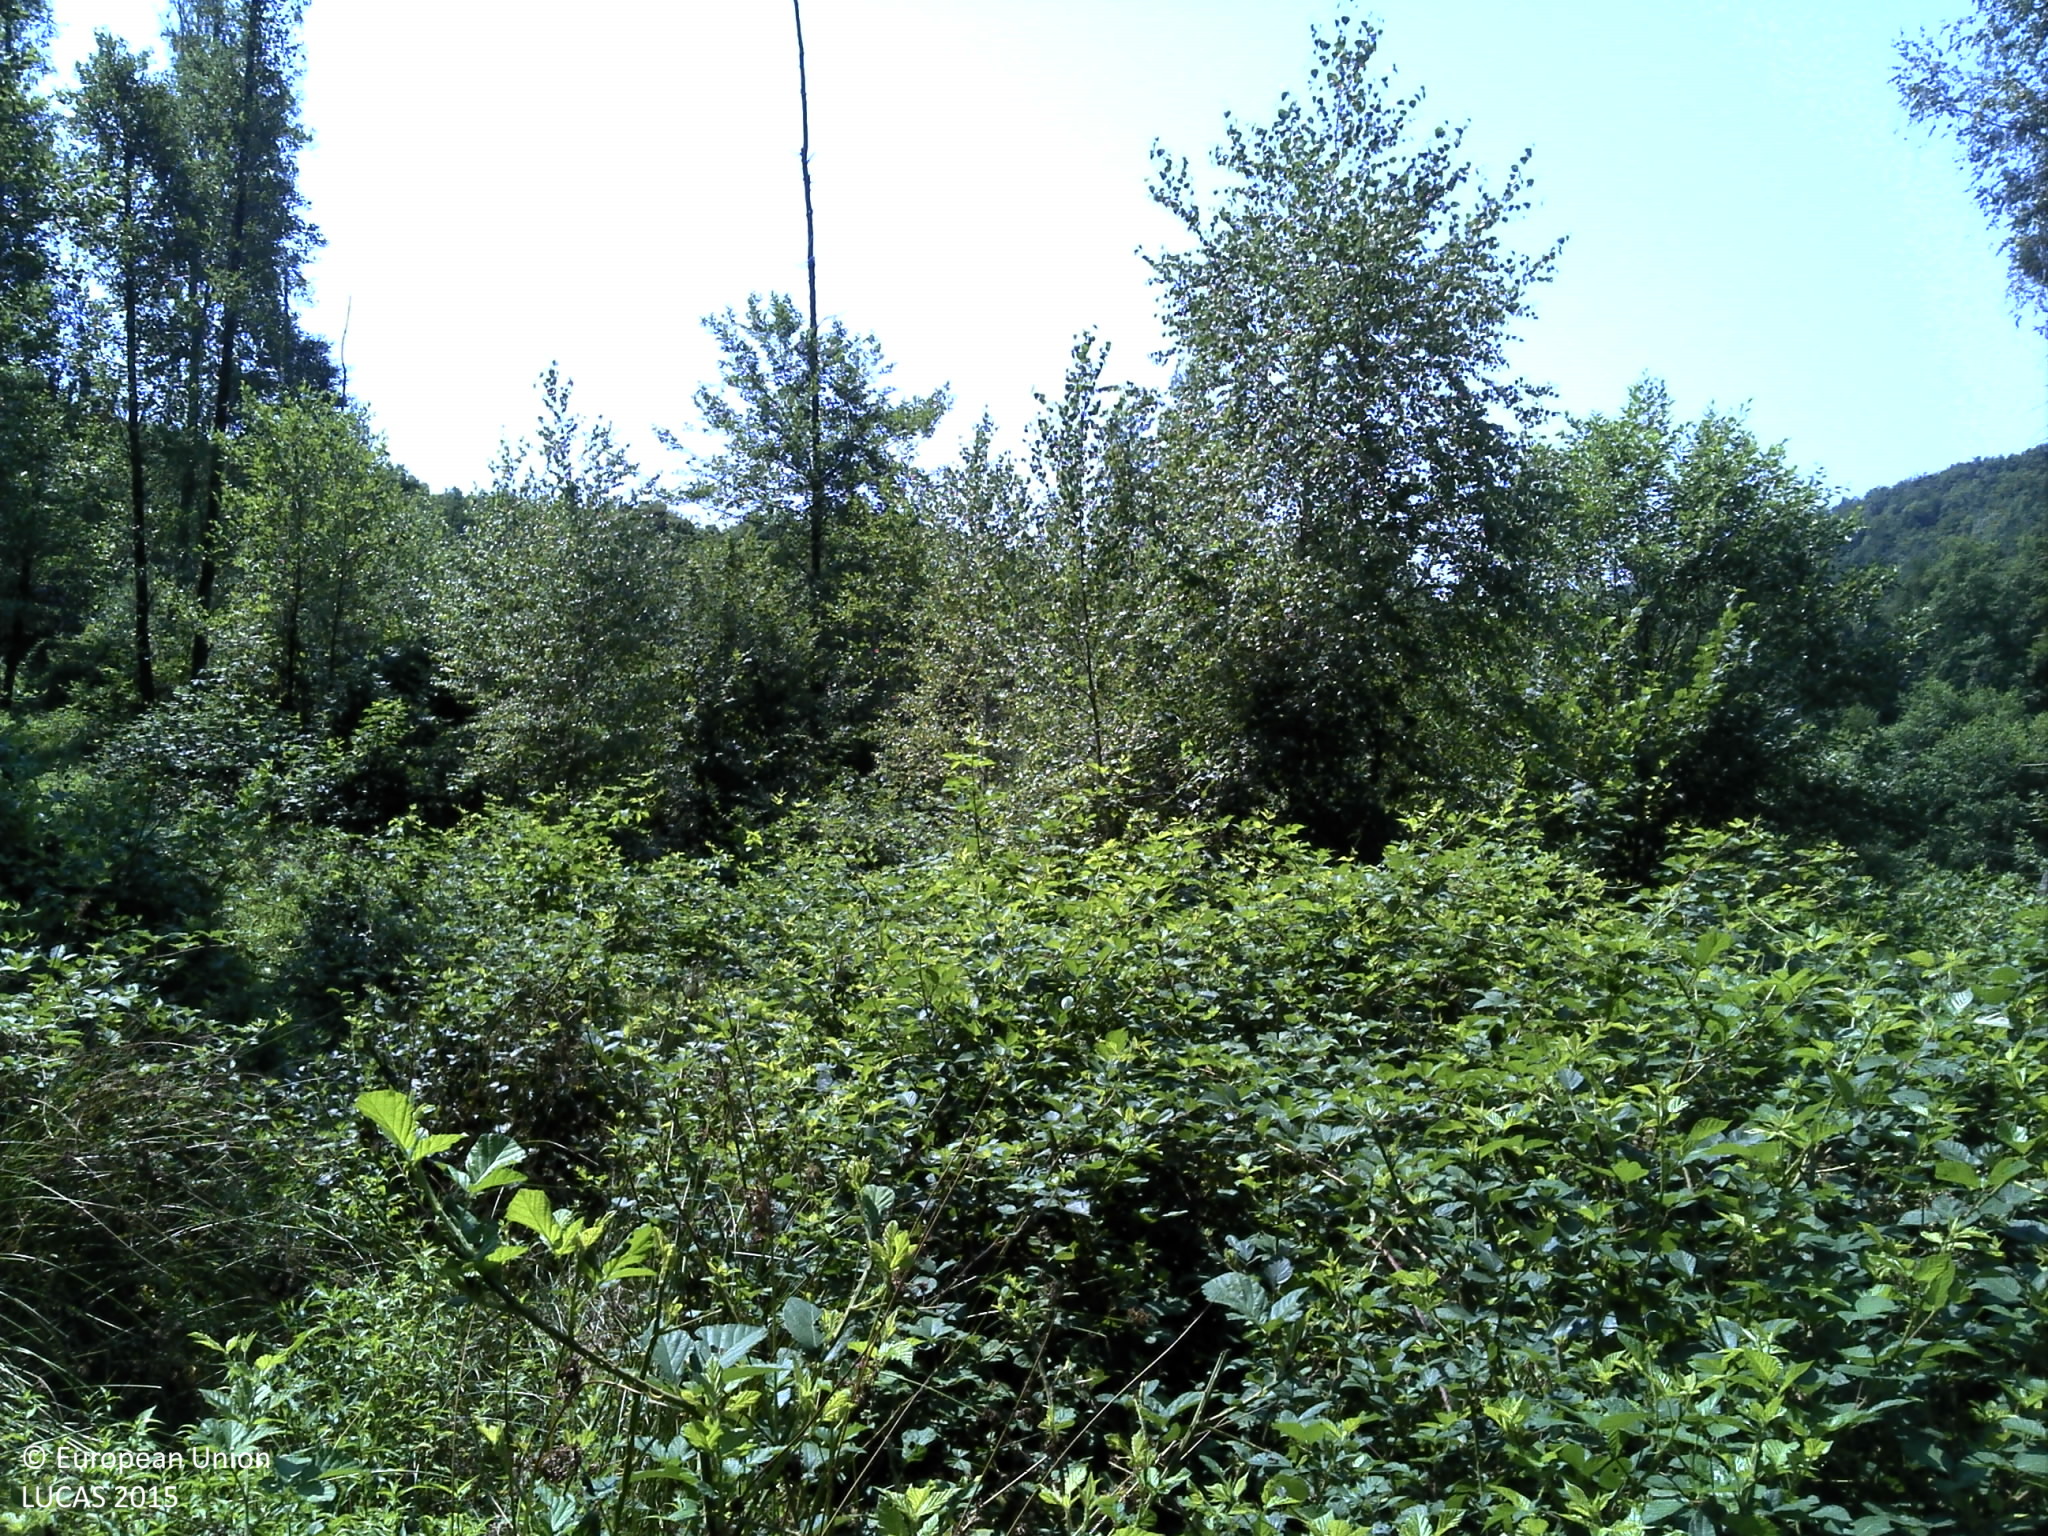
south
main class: Shrubland
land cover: Shrubland with sparse tree cover
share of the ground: > 75 %
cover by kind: shrubs 95 %, broadleaved forest trees 5 %
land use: Forestry
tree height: < 5 m
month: July
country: HR
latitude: 45.5969
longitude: 16.7295
